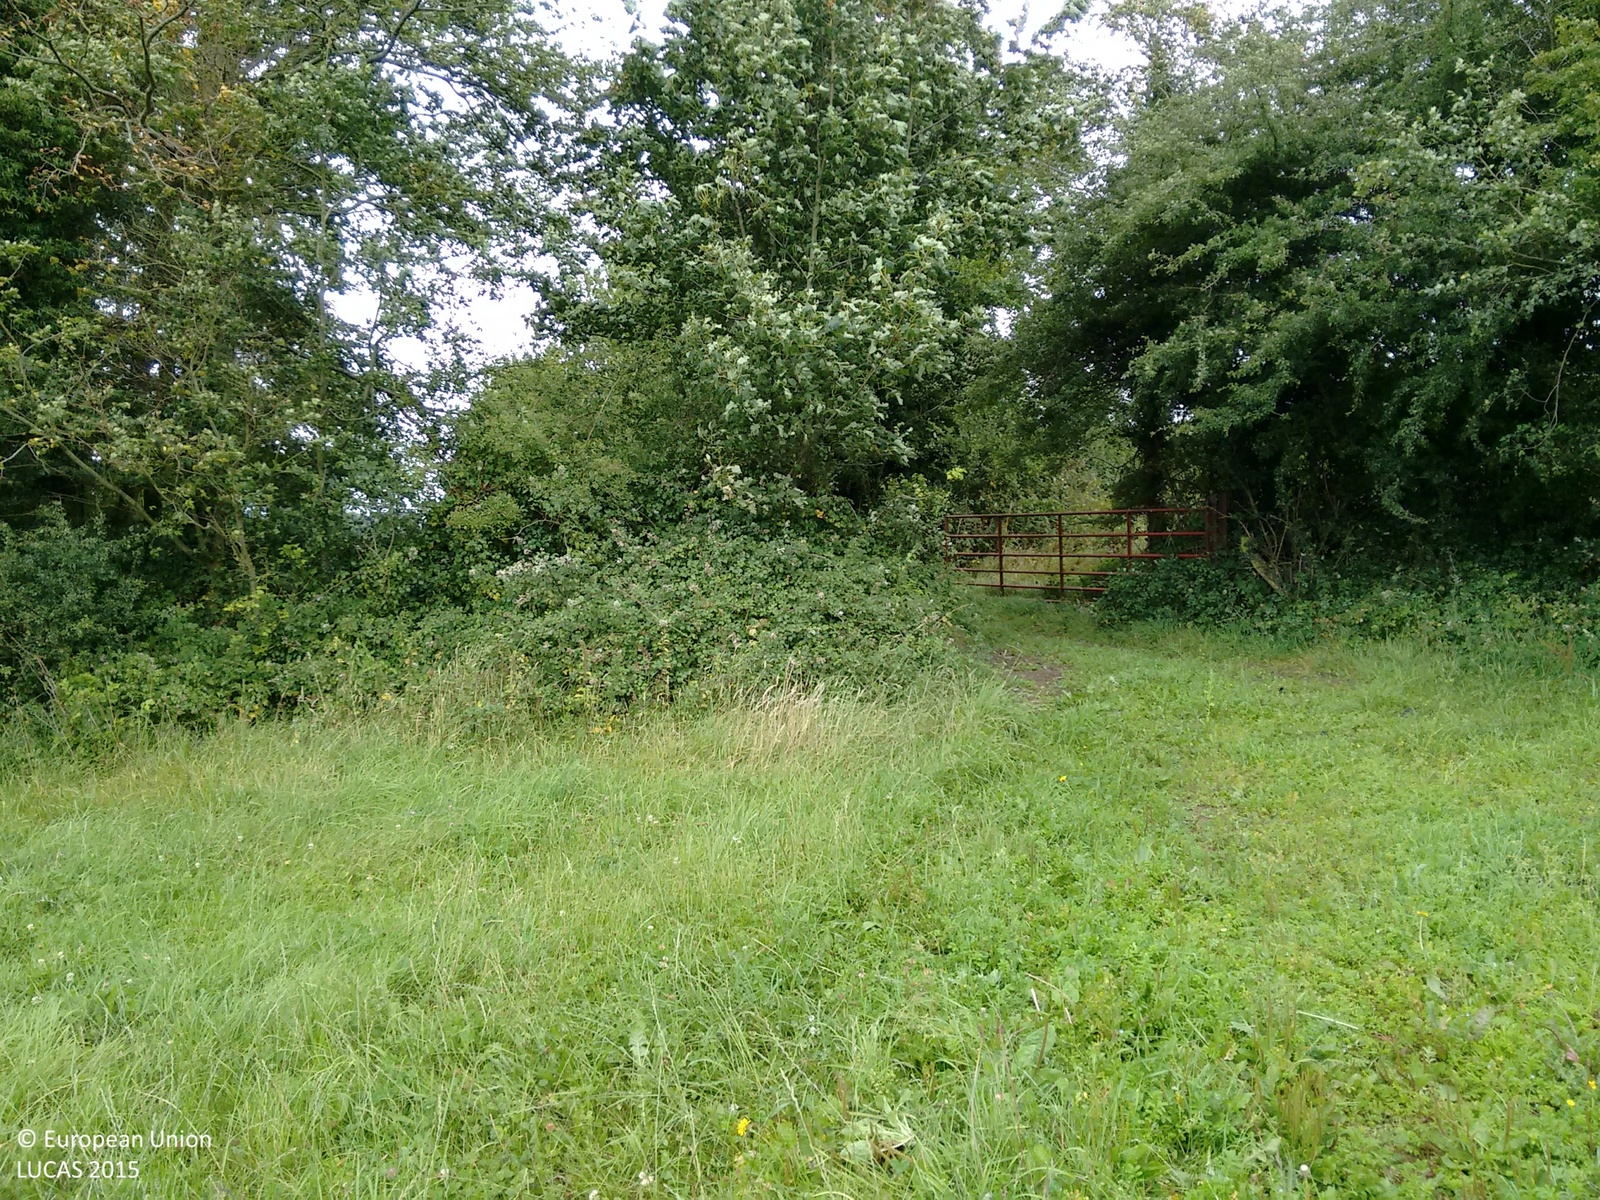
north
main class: Grassland
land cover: Grassland without tree/shrub cover
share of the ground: > 75 %
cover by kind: herbaceous plants 100 %
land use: Agriculture (excluding fallow land and kitchen gardens)
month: August
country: IE
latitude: 52.8729
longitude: -7.3431
